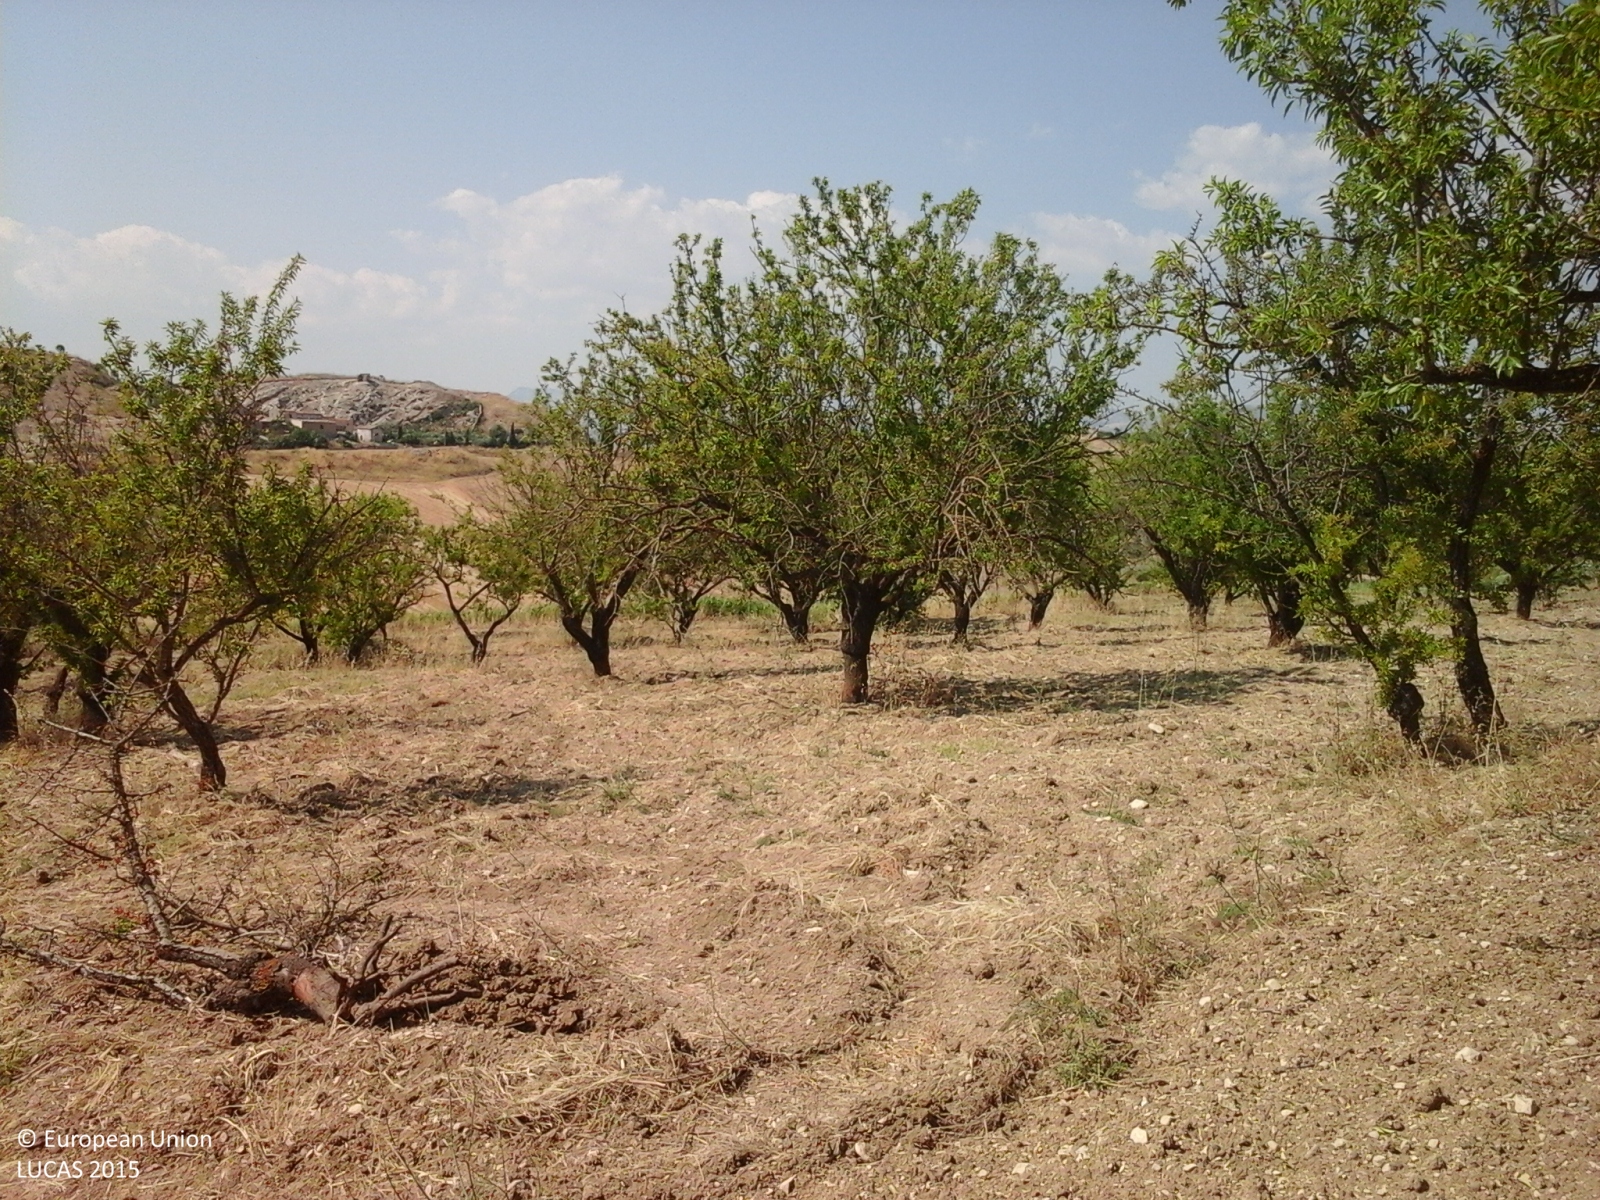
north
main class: Cropland
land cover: Nuts trees
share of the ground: 50 - 75 %
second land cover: Other bare soil
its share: > 75 %
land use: Agriculture (excluding fallow land and kitchen gardens)
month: July
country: IT
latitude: 37.4440
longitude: 13.5783
